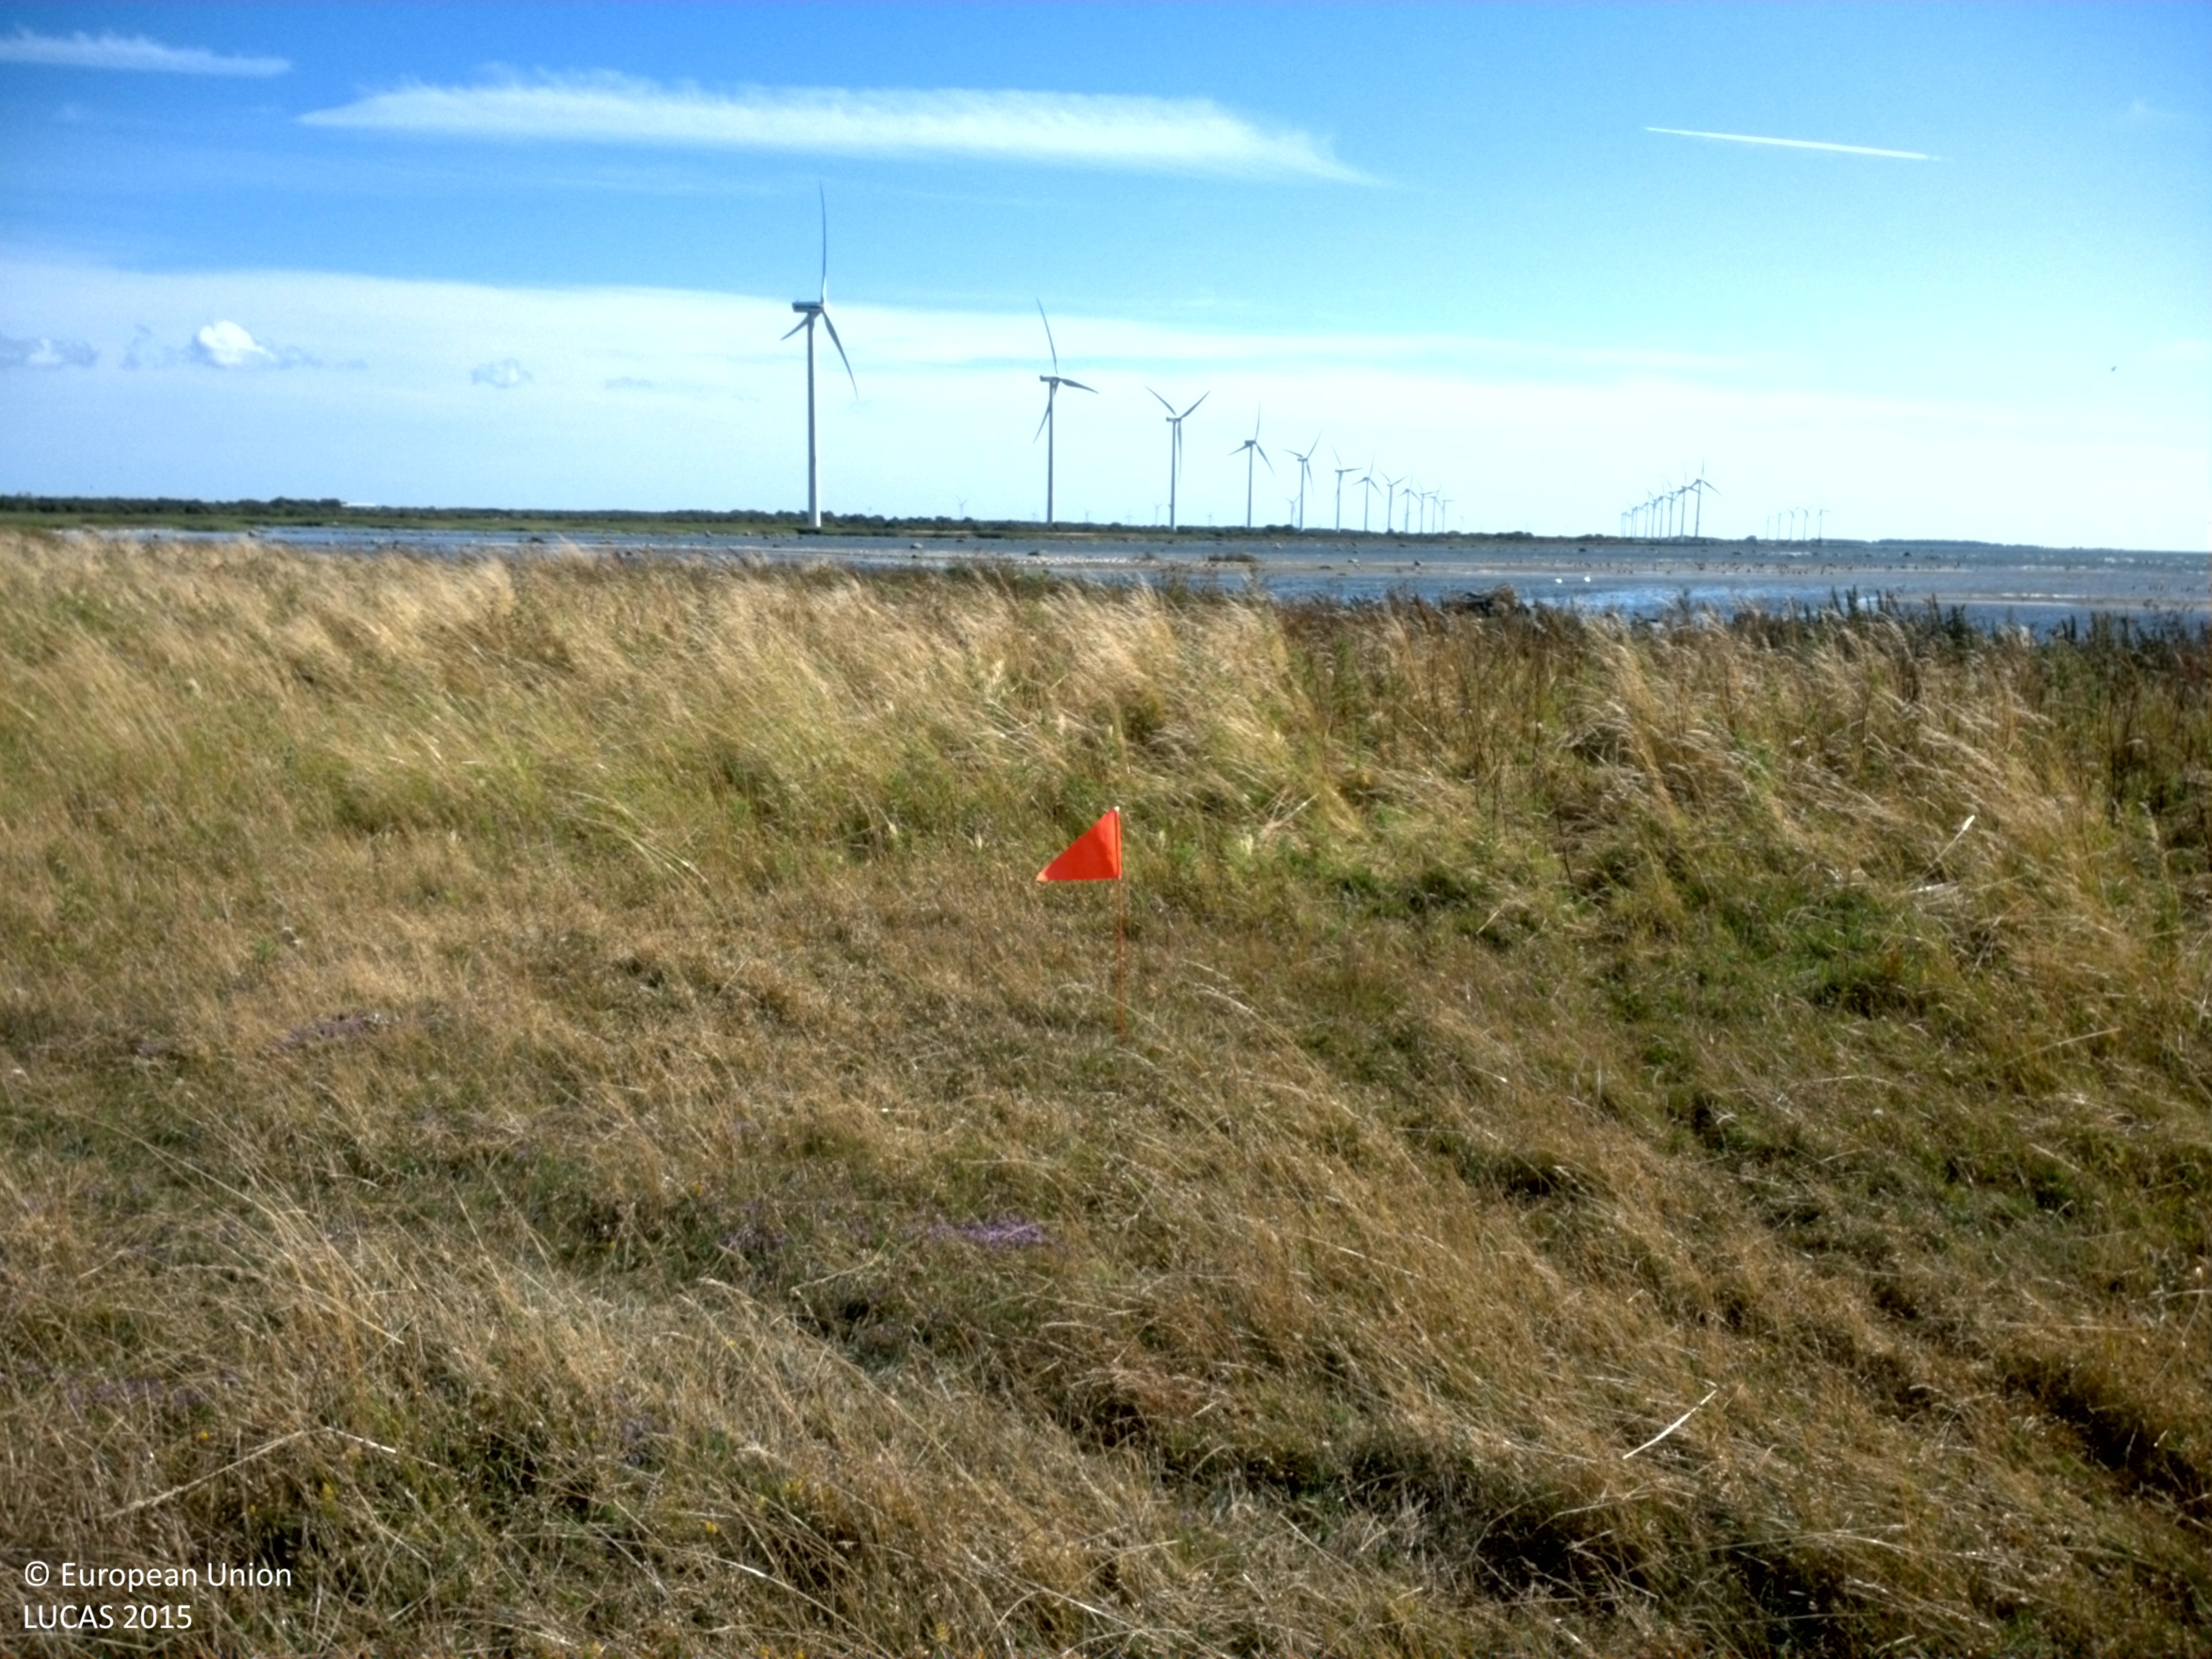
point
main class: Grassland
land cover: Grassland without tree/shrub cover
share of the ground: > 75 %
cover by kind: herbaceous plants 100 %
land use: Agriculture (excluding fallow land and kitchen gardens)
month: July
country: SE
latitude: 57.1176
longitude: 18.2160
